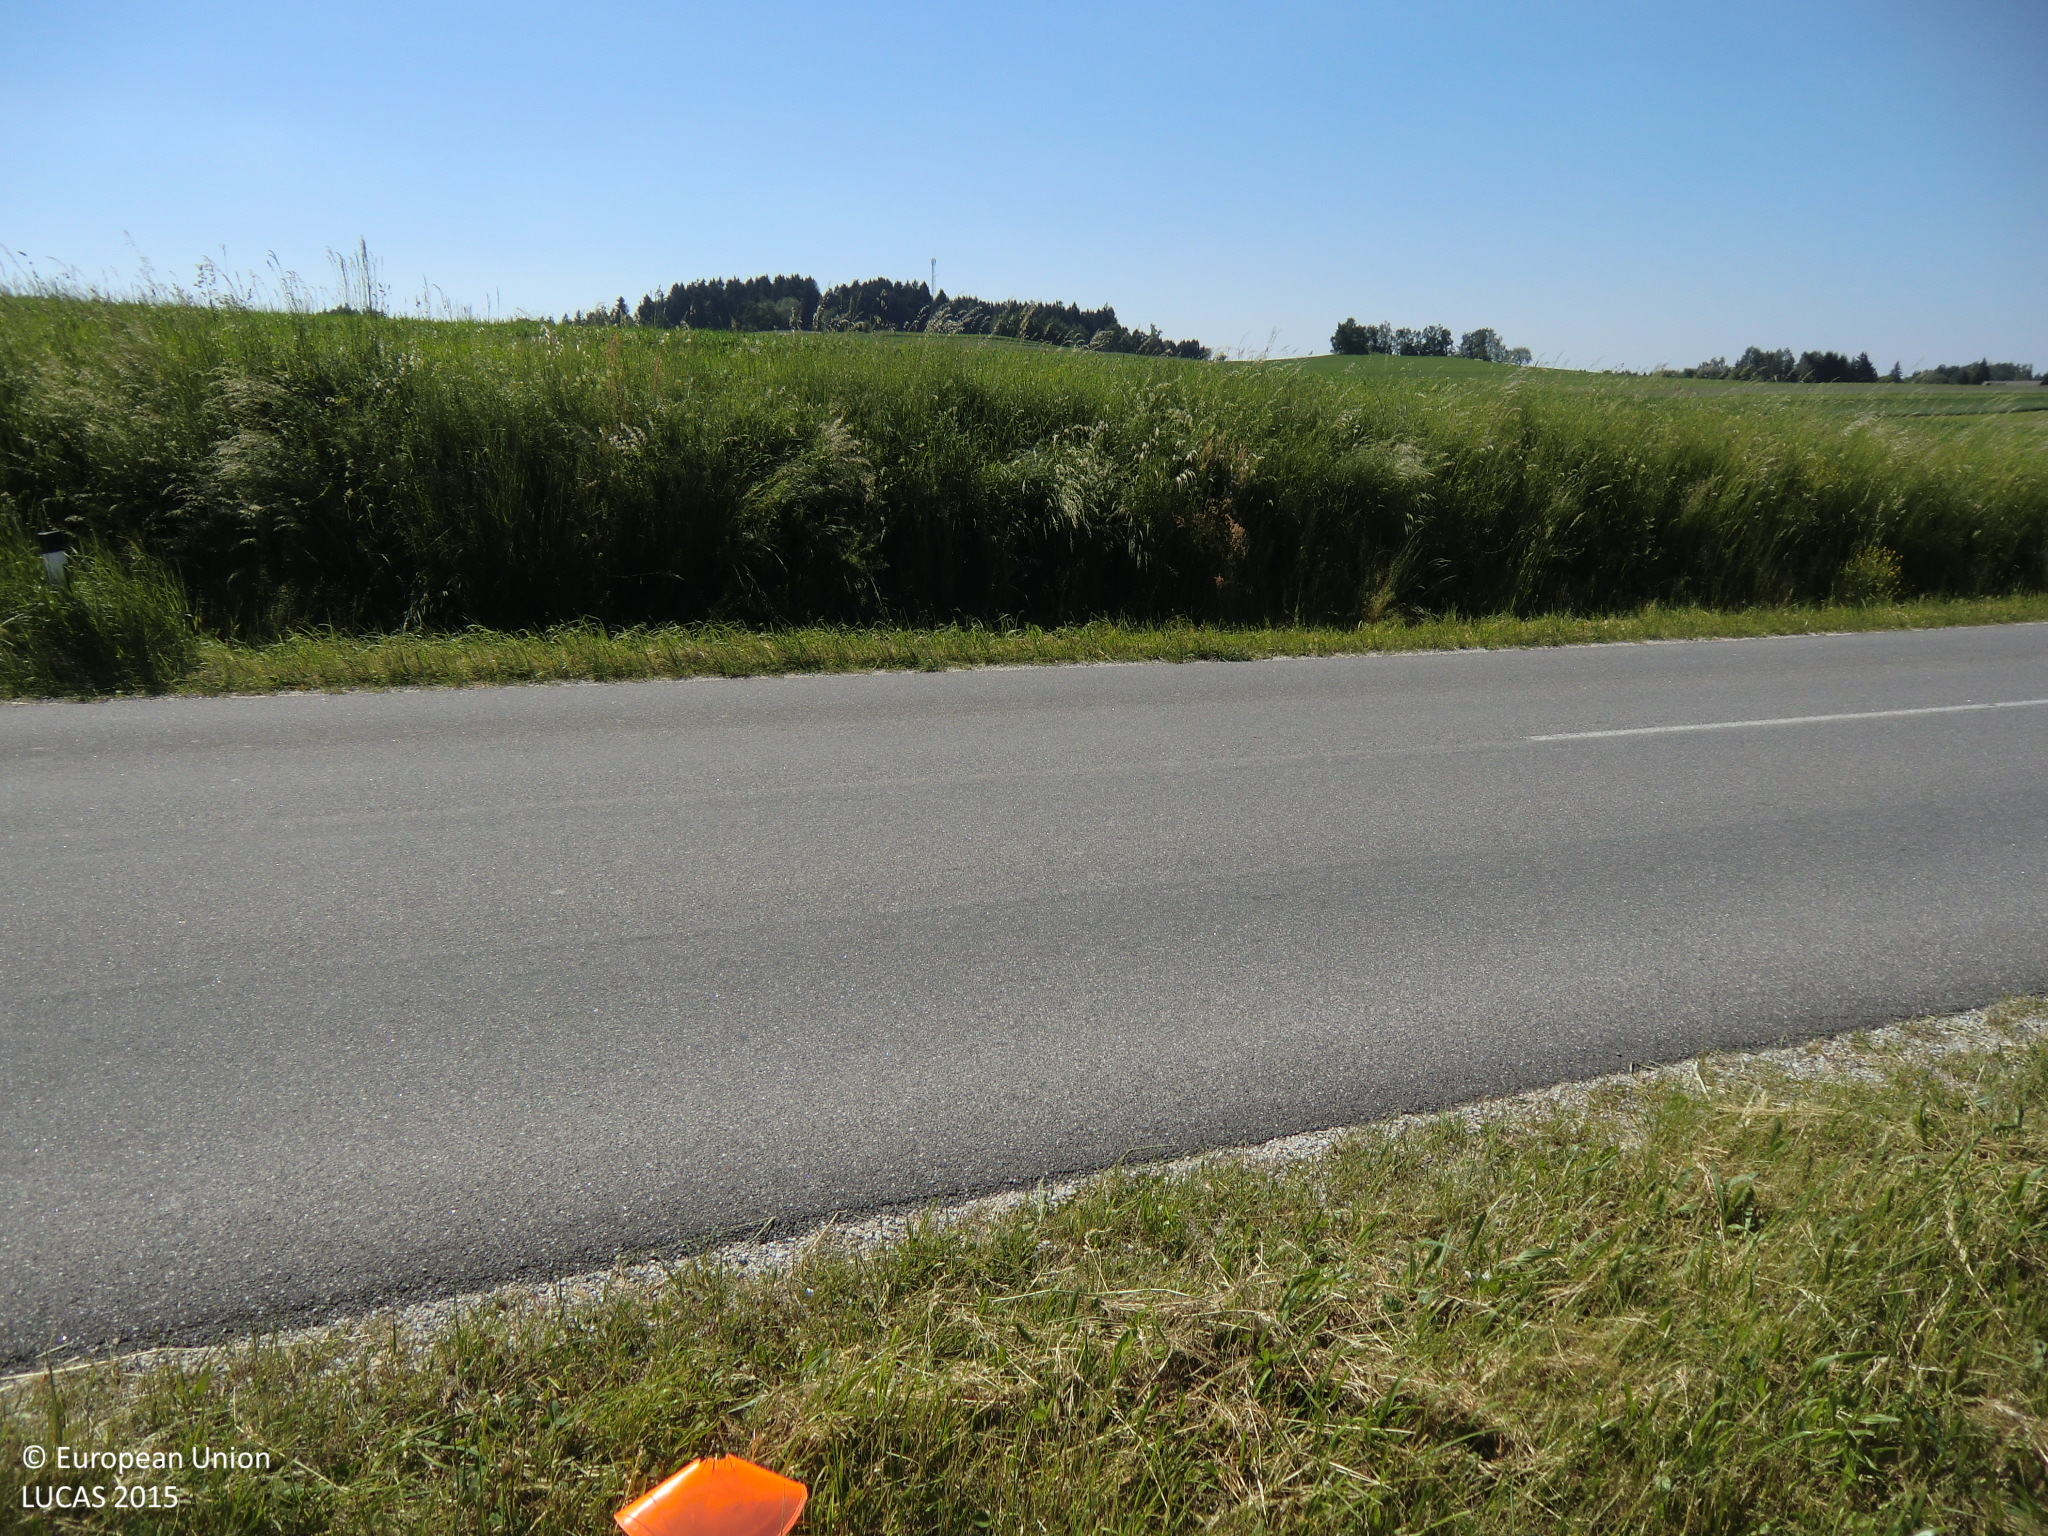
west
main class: Grassland
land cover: Grassland without tree/shrub cover
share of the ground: > 75 %
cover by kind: herbaceous plants 100 %
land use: Road transport
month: June
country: AT
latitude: 48.7223
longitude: 15.0178
